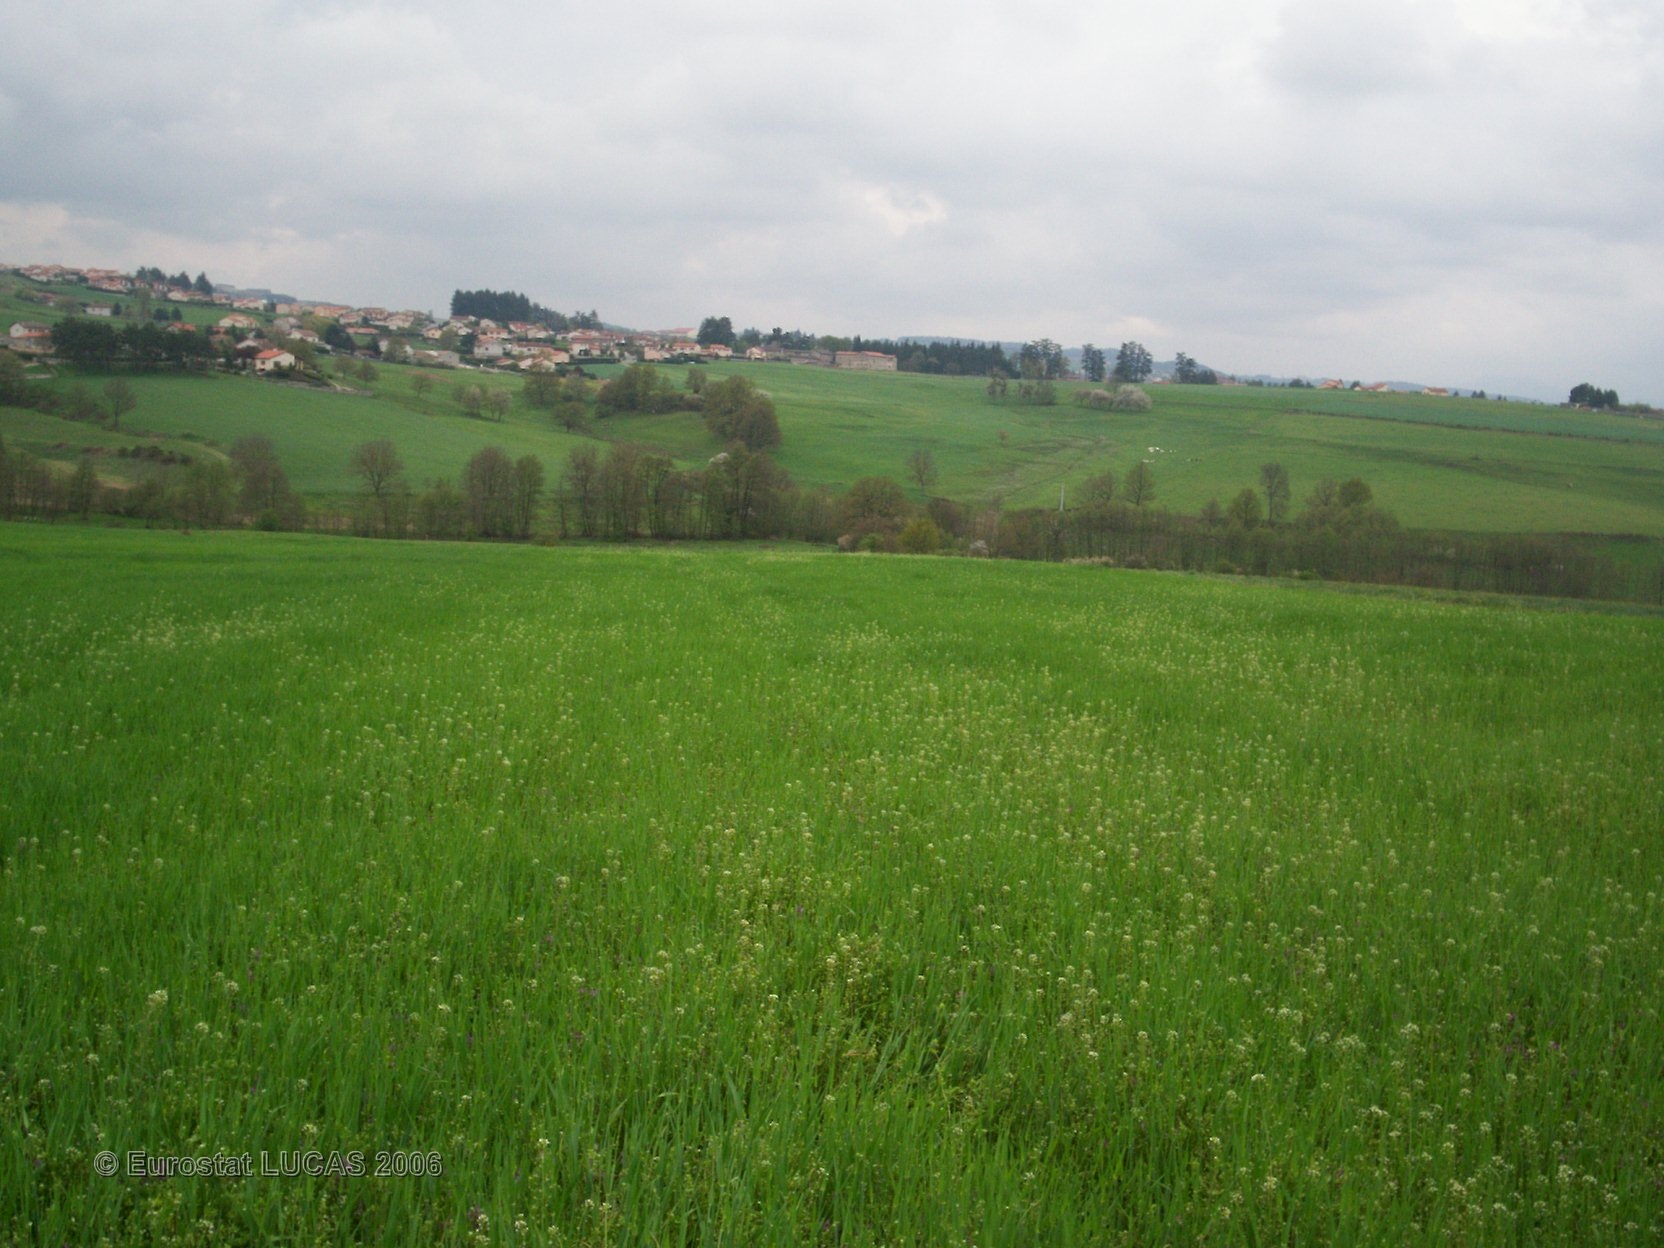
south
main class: Cropland
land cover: Barley
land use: Agriculture (excluding fallow land and kitchen gardens)
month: April
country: FR
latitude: 45.3075
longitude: 4.1752
